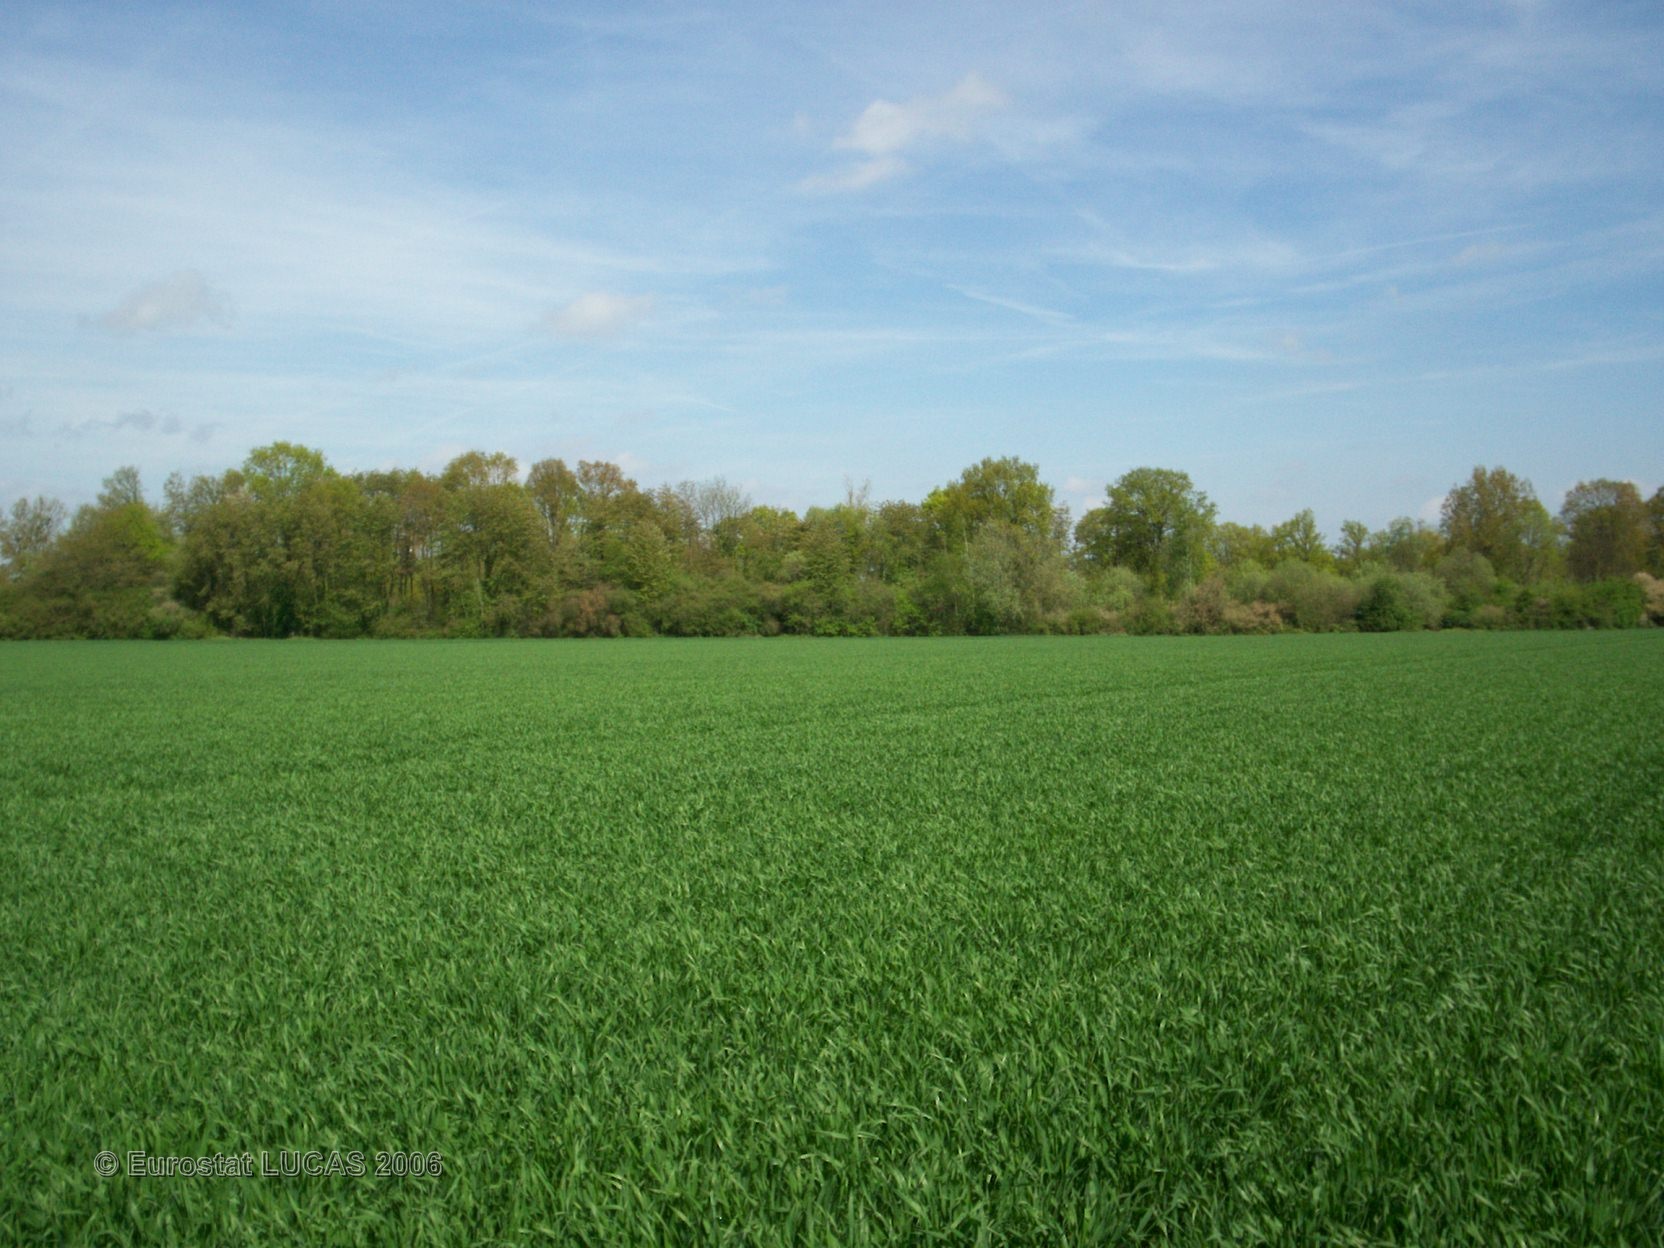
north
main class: Cropland
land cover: Common wheat
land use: Agriculture (excluding fallow land and kitchen gardens)
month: May
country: FR
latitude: 48.8411
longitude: 2.8645
